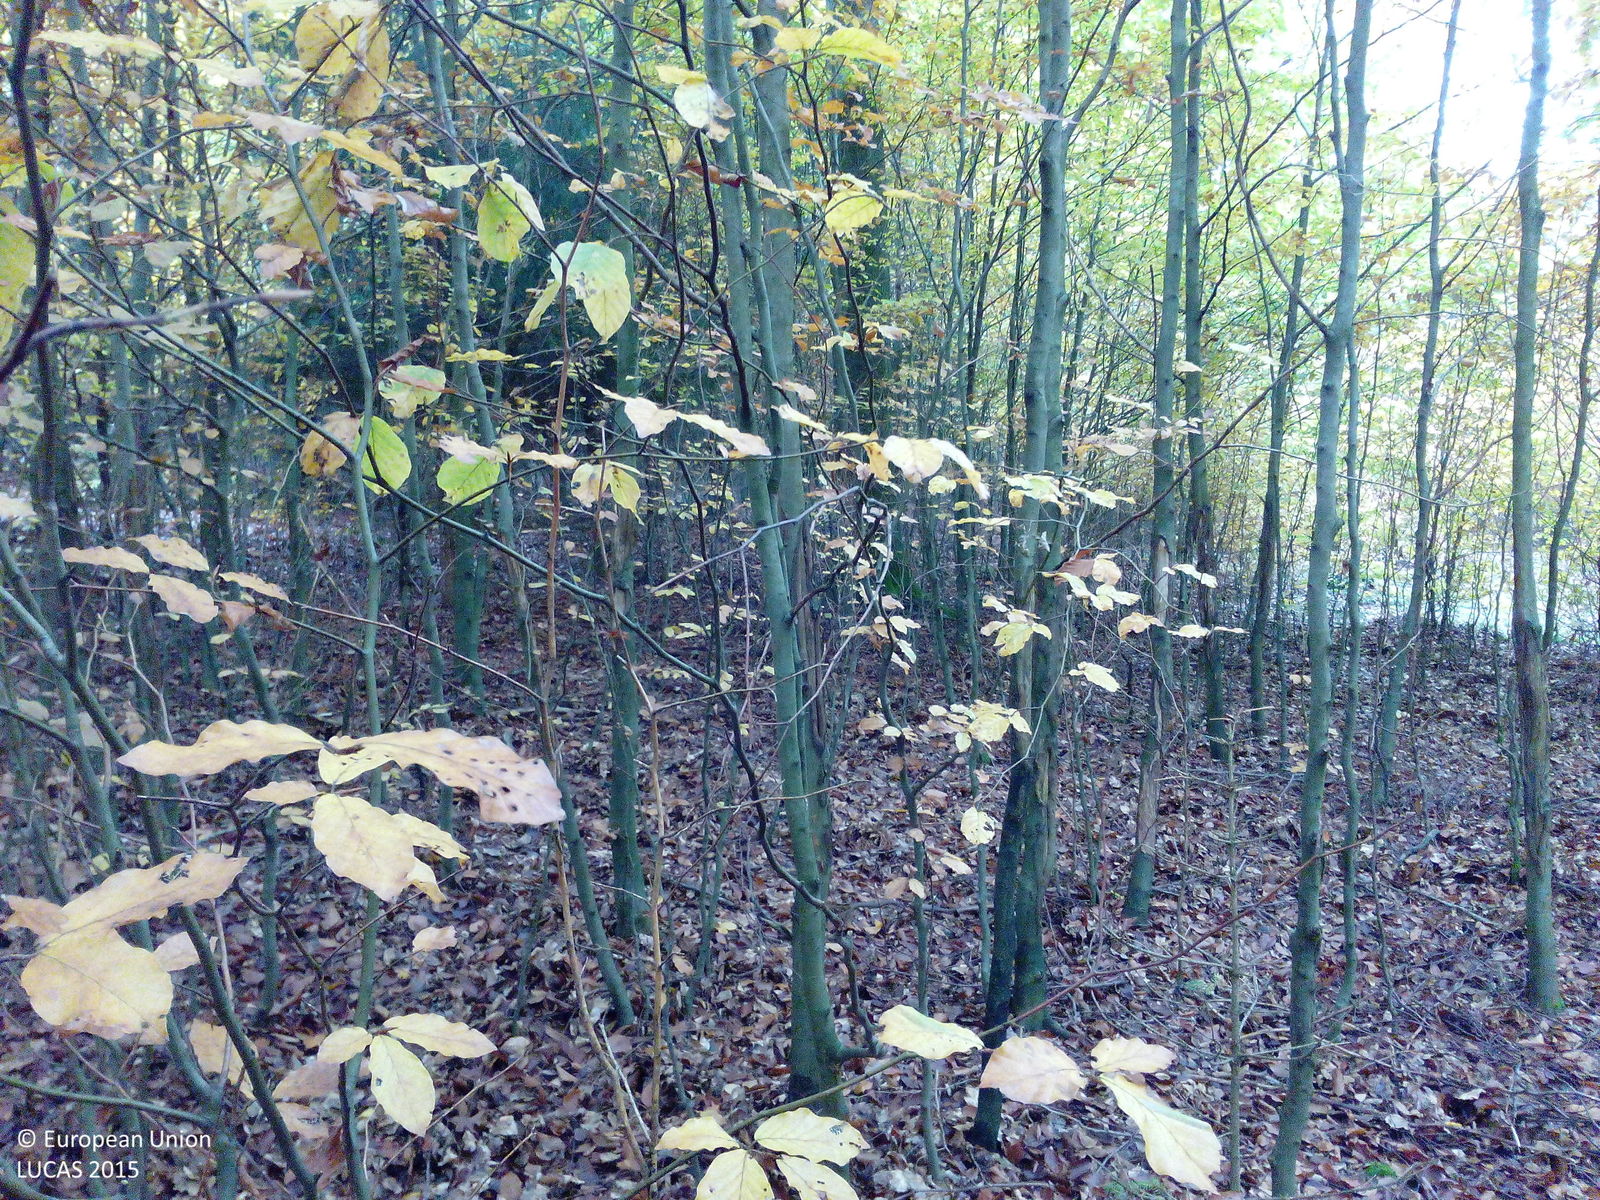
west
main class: Woodland
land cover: Broadleaved woodland
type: mesophytic deciduous forest
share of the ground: > 75 %
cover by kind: broadleaved forest trees 70 %, unconsolidated bare surface 15 %, coniferous forest trees 10 %, lichens and mosses 5 %
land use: Forestry
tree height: > 5 m
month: October
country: DE
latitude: 50.2561
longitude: 9.9019
